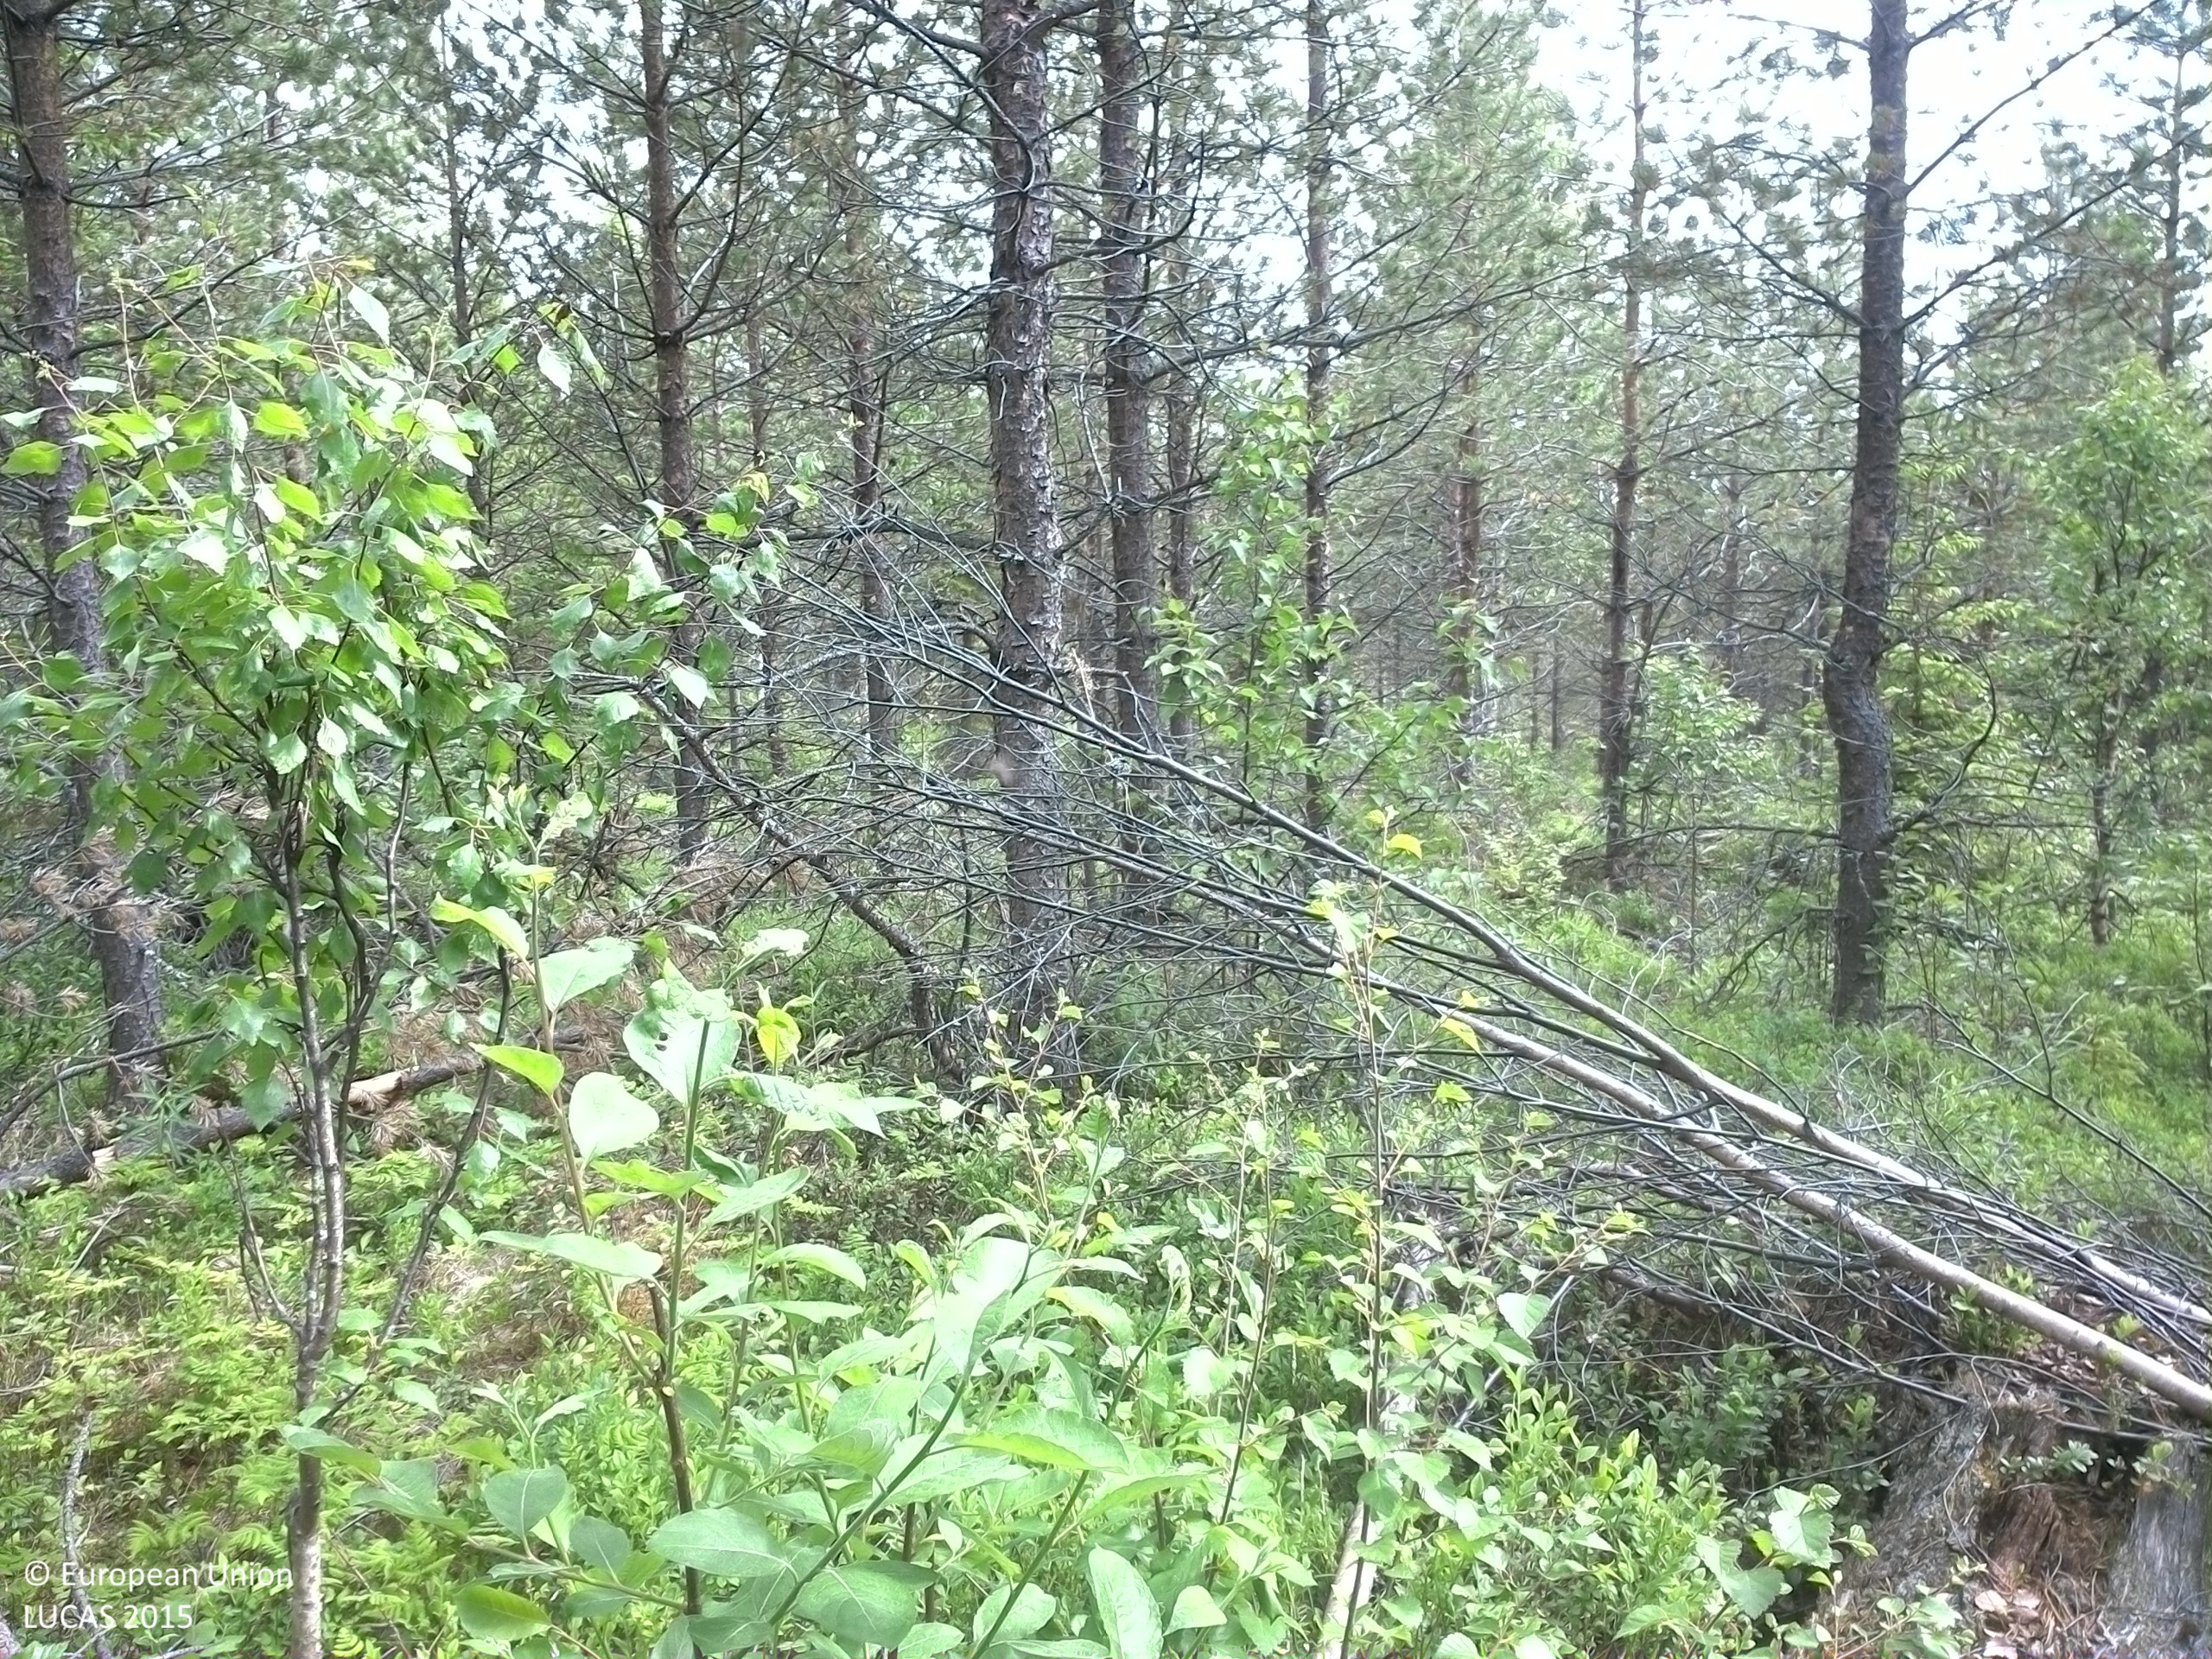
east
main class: Woodland
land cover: Pine dominated coniferous woodland
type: boreal forest
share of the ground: 50 - 75 %
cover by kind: coniferous forest trees 55 %, shrubs 25 %, broadleaved forest trees 5 %, herbaceous plants 5 %, lichens and mosses 5 %, consolidated bare surface 5 %
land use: Forestry
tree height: > 5 m
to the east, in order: Pine dominated coniferous woodland
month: July
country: SE
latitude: 64.1413
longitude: 16.8538
